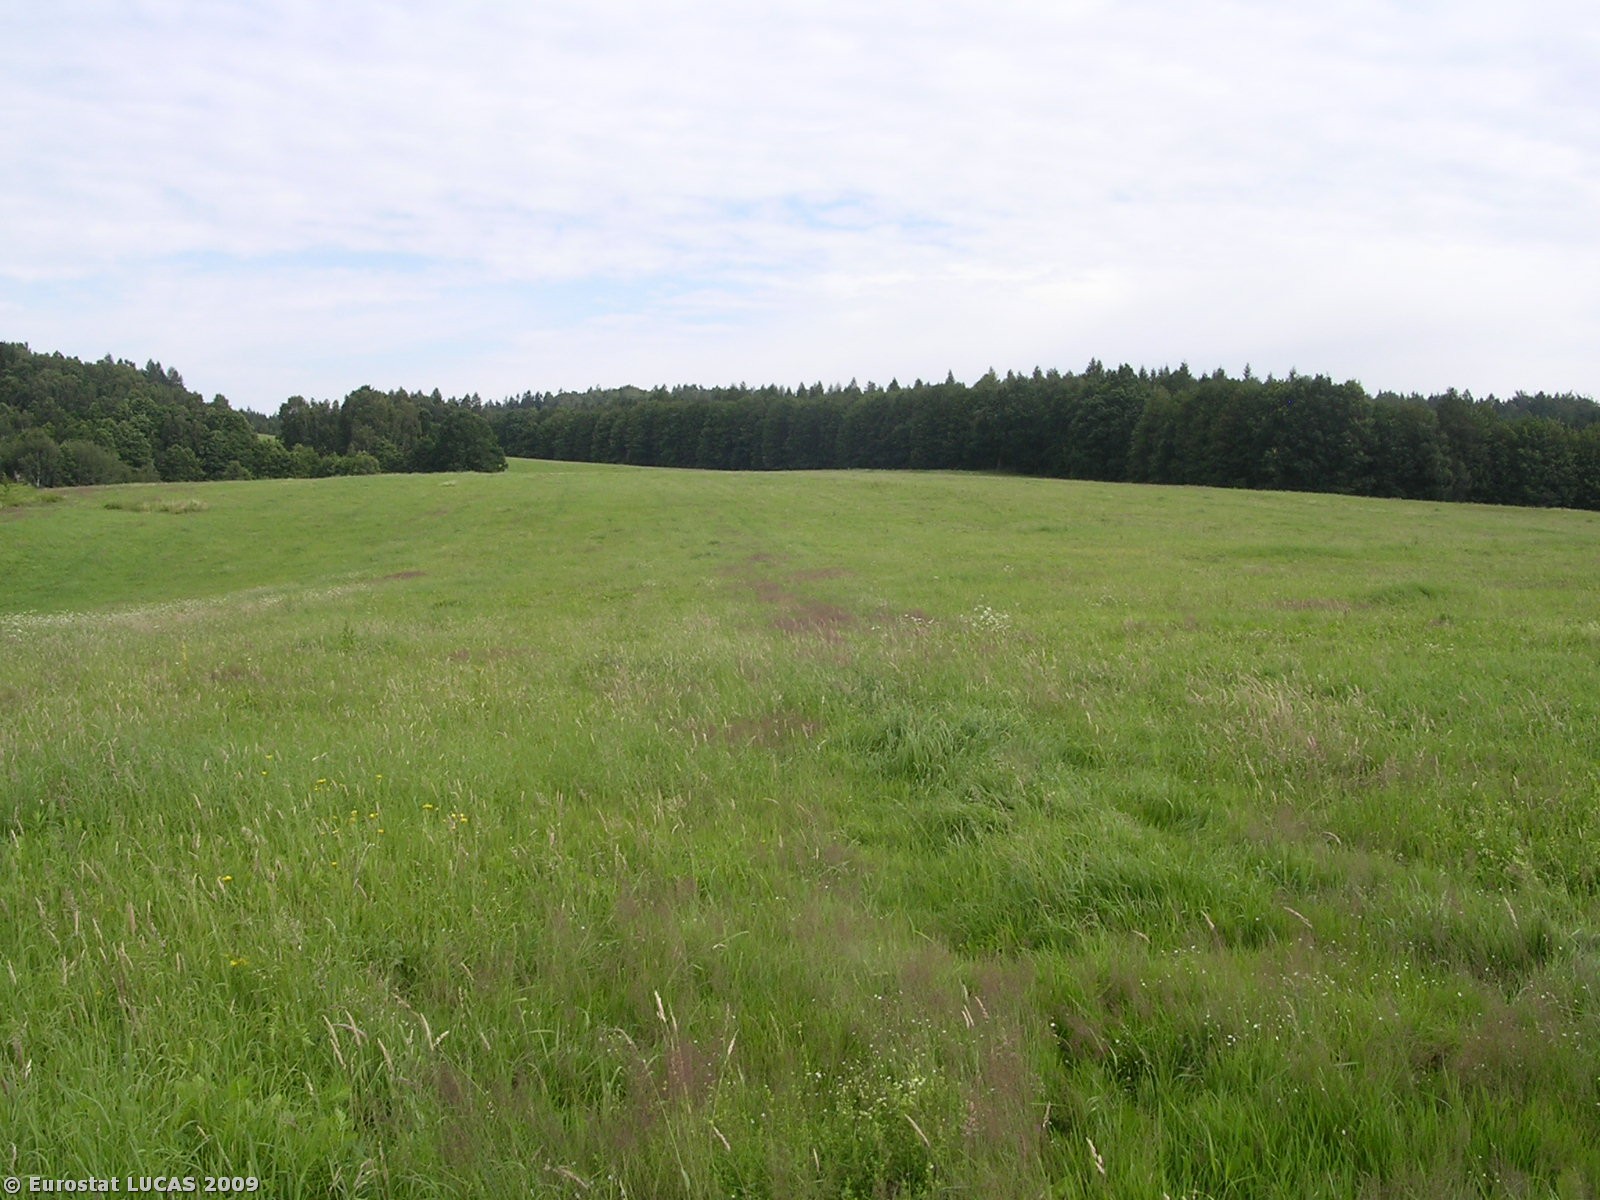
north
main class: Grassland
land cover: Grassland without tree/shrub cover
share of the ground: > 75 %
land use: Agriculture (excluding fallow land and kitchen gardens)
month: July
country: CZ
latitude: 50.7948
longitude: 15.0109
